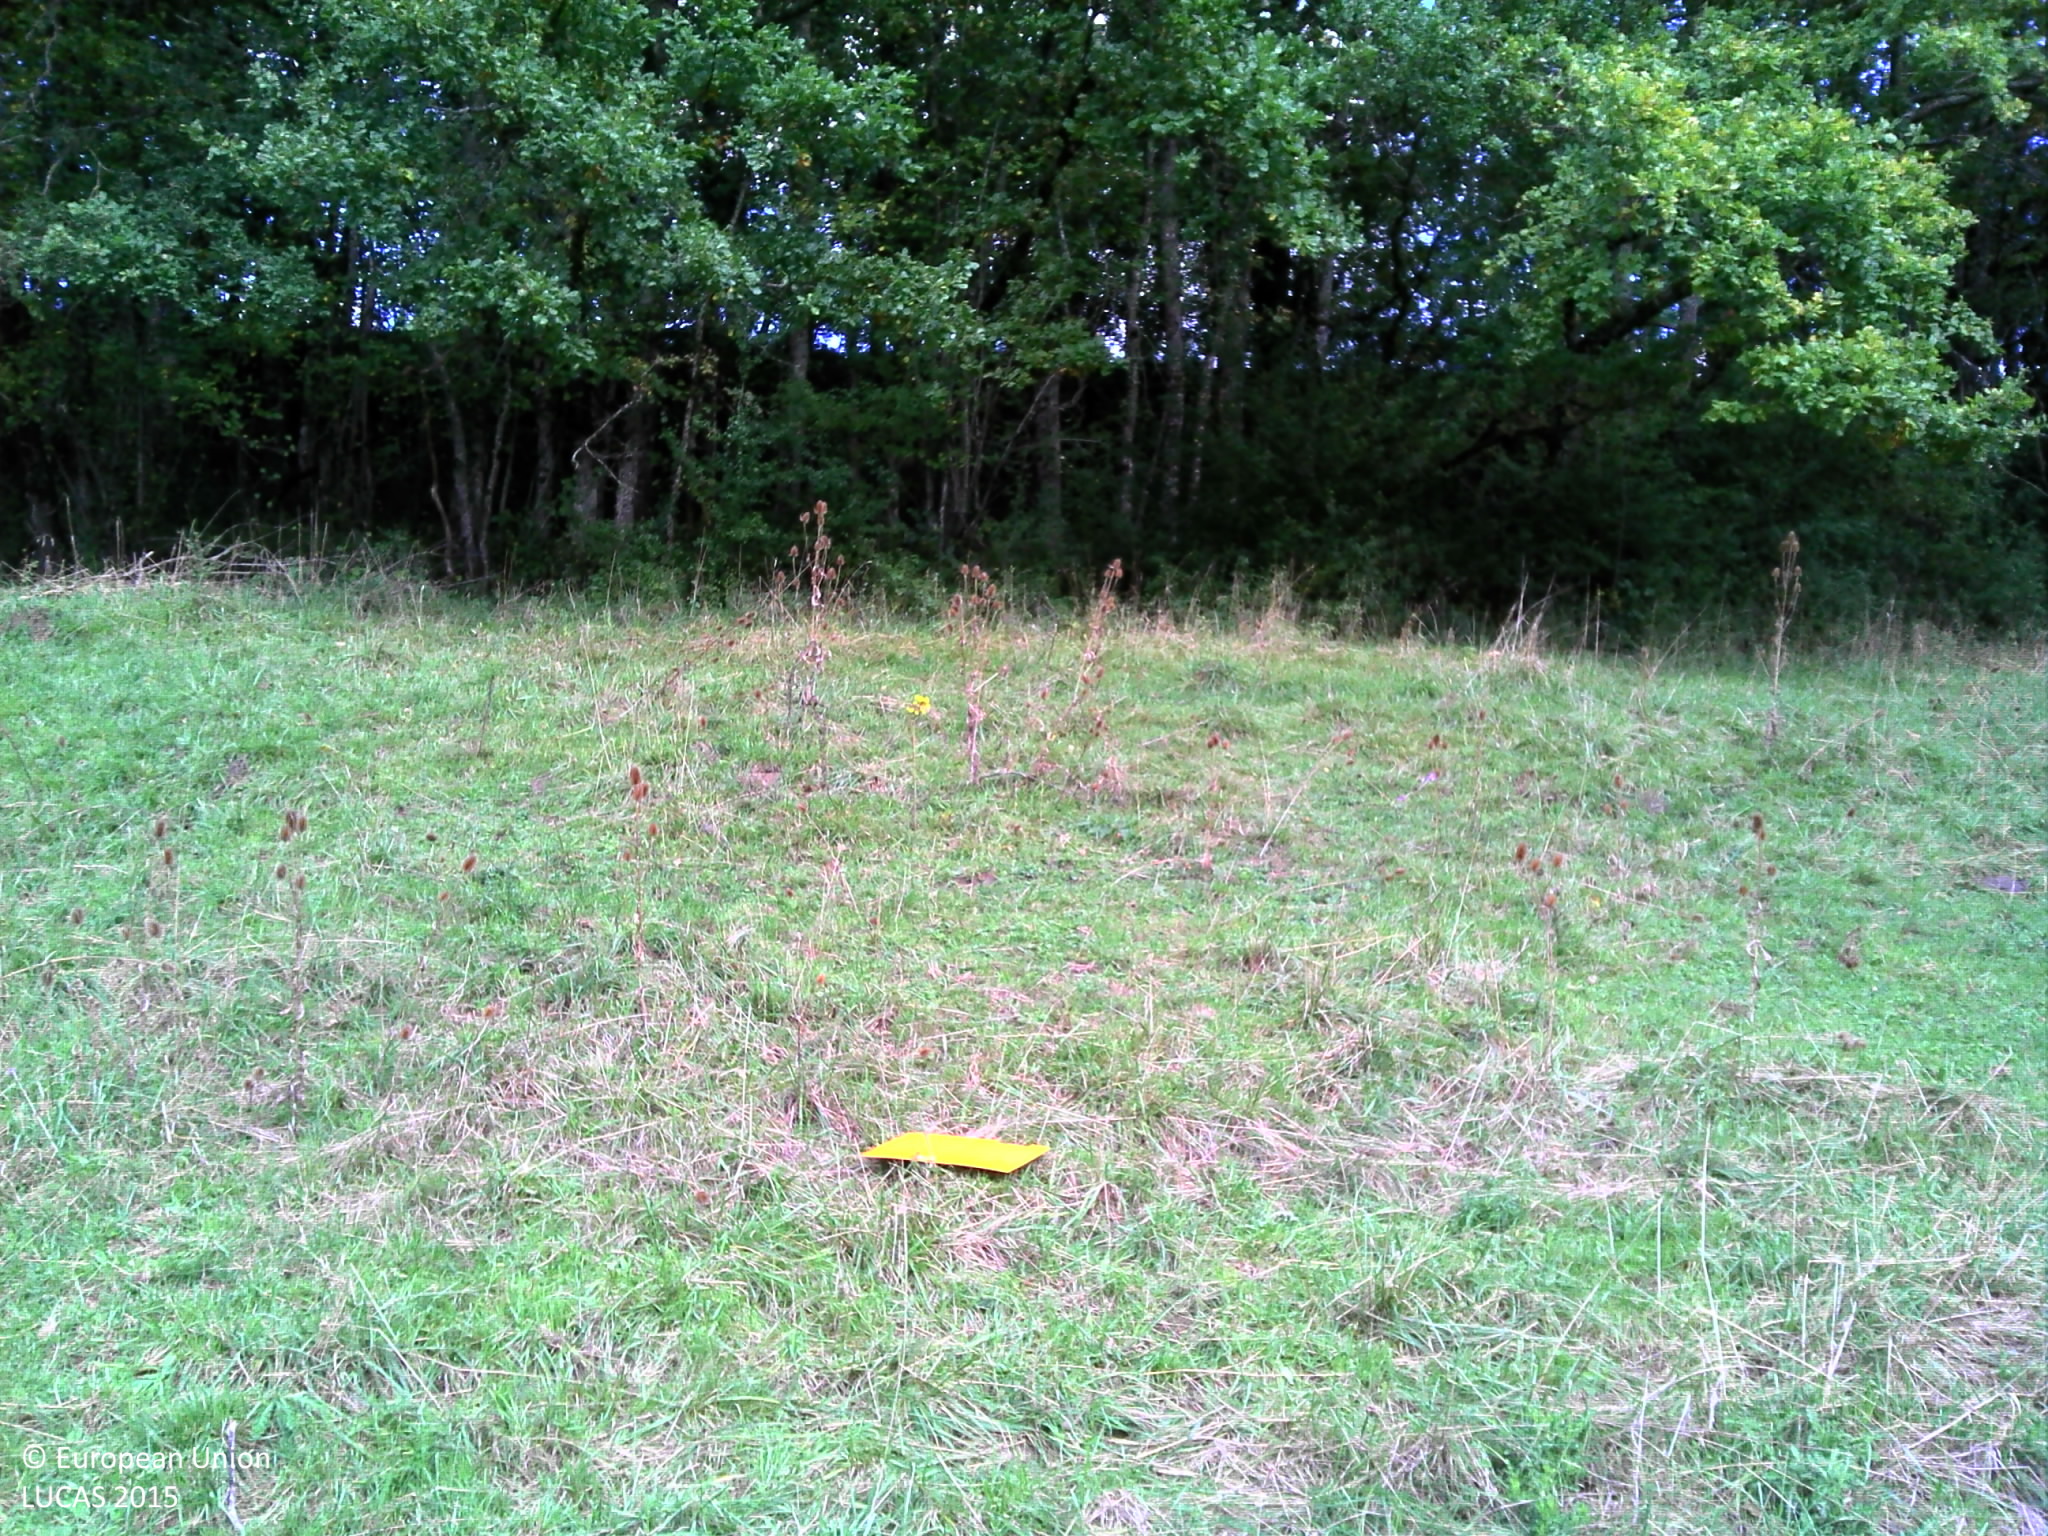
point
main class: Grassland
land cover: Grassland without tree/shrub cover
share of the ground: > 75 %
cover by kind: herbaceous plants 100 %
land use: Agriculture (excluding fallow land and kitchen gardens)
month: September
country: FR
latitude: 47.1335
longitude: 6.2710
